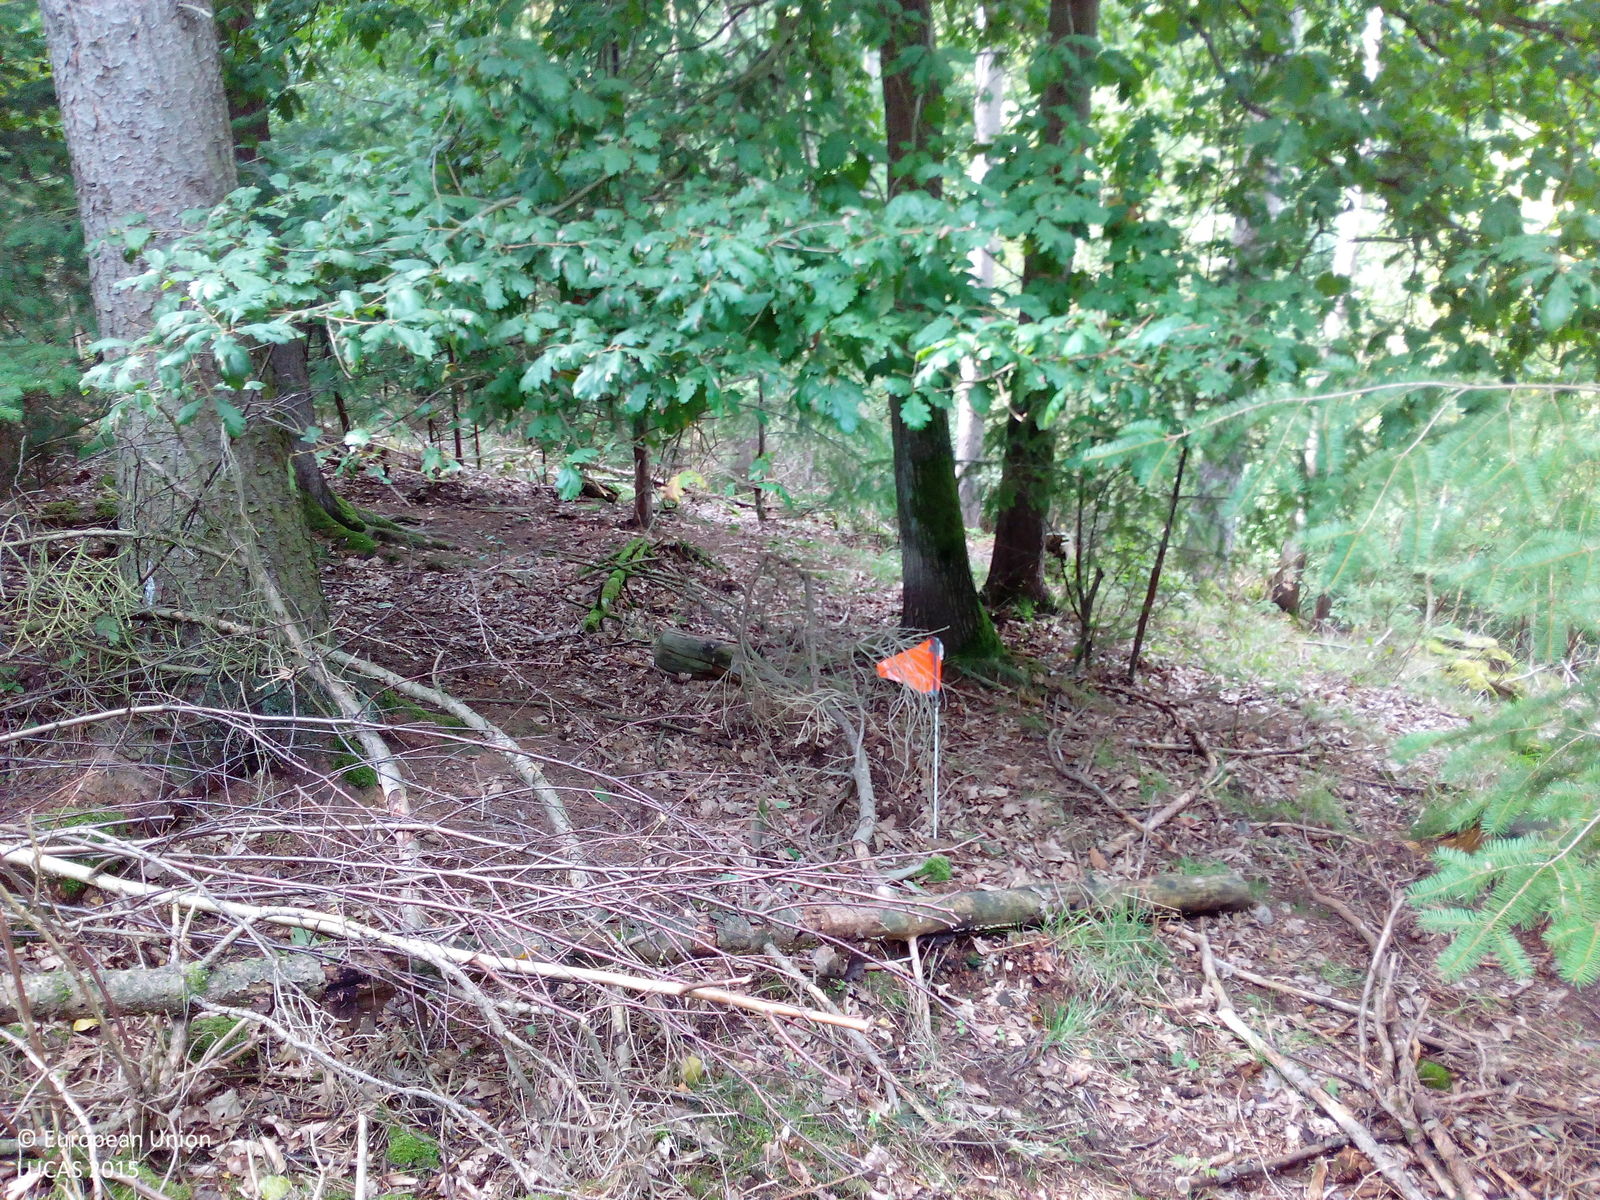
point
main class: Woodland
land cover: Spruce dominated mixed woodland
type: hemiboreal forest and nemoral coniferous forest and mixed broadleaved-coniferous forest
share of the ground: 50 - 75 %
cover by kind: coniferous forest trees 35 %, broadleaved forest trees 25 %, herbaceous plants 20 %, lichens and mosses 10 %, unconsolidated bare surface 10 %
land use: Forestry
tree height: > 5 m
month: September
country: DE
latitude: 50.4455
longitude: 8.6062
